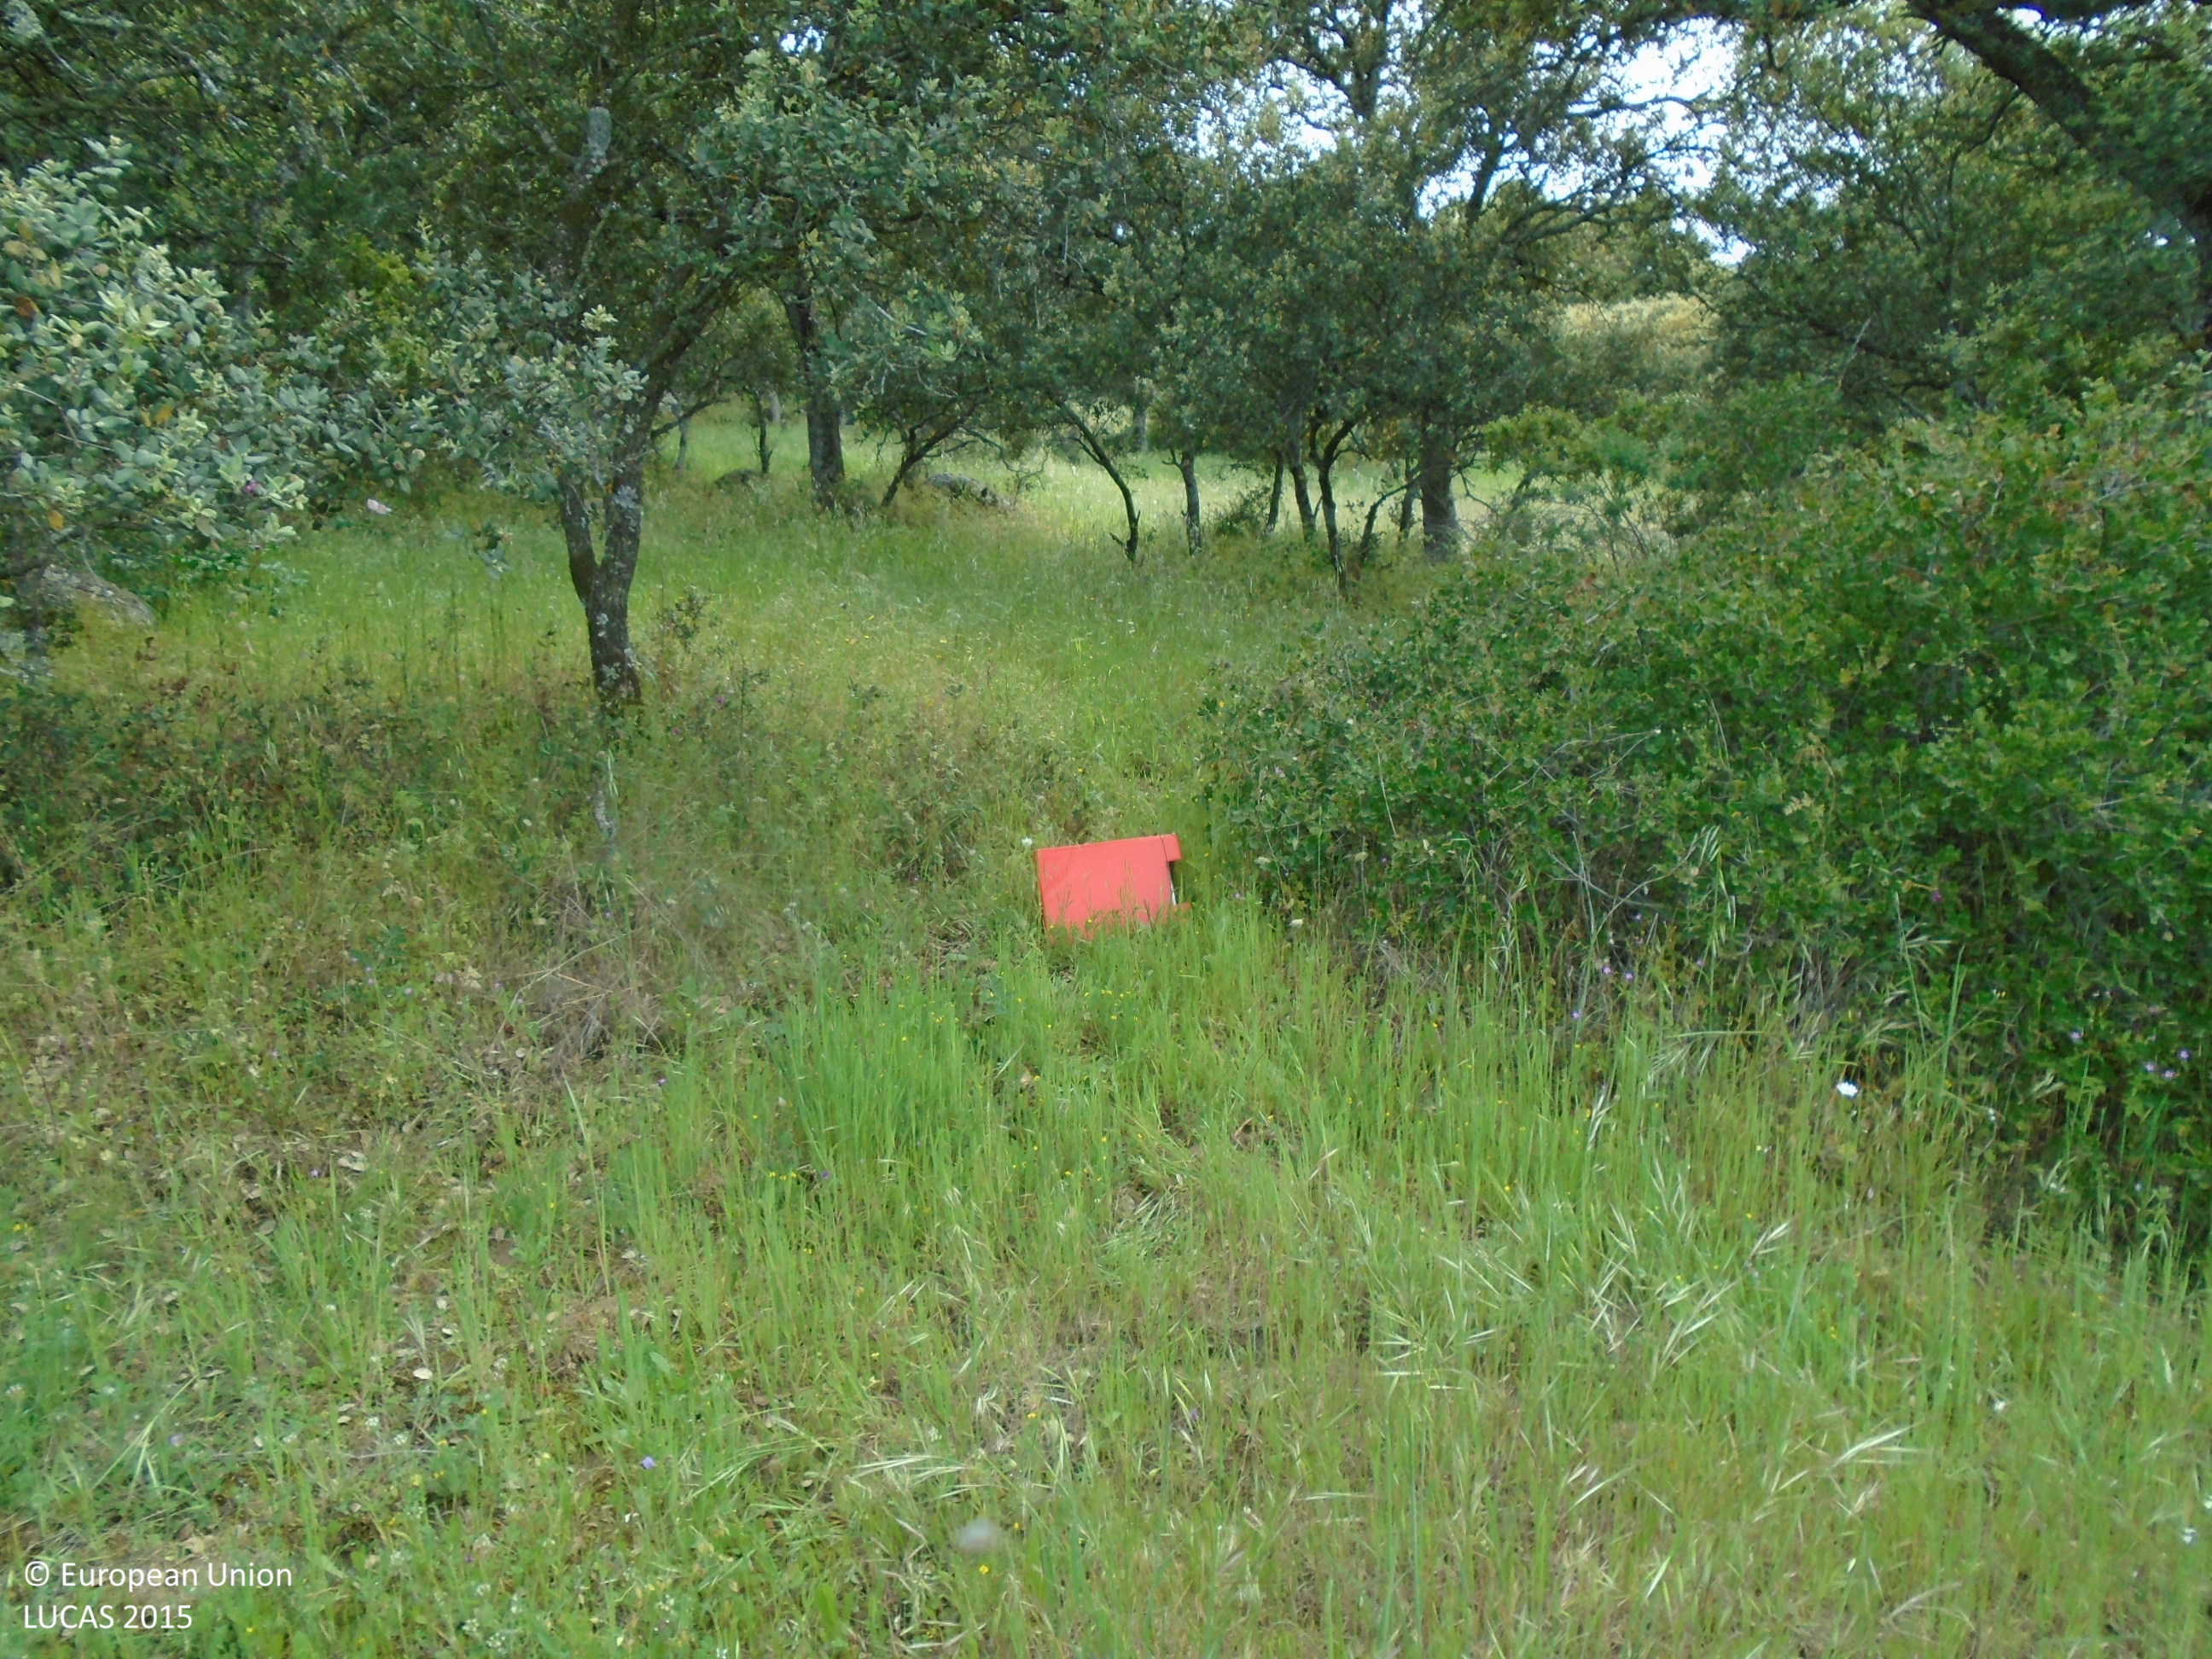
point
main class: Woodland
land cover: Broadleaved woodland
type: broadleaved evergreen forest
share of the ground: > 75 %
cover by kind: broadleaved forest trees 90 %, shrubs 5 %, herbaceous plants 5 %
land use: Semi-natural and natural areas not in use
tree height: > 5 m
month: May
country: ES
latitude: 39.7568
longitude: -4.7146
